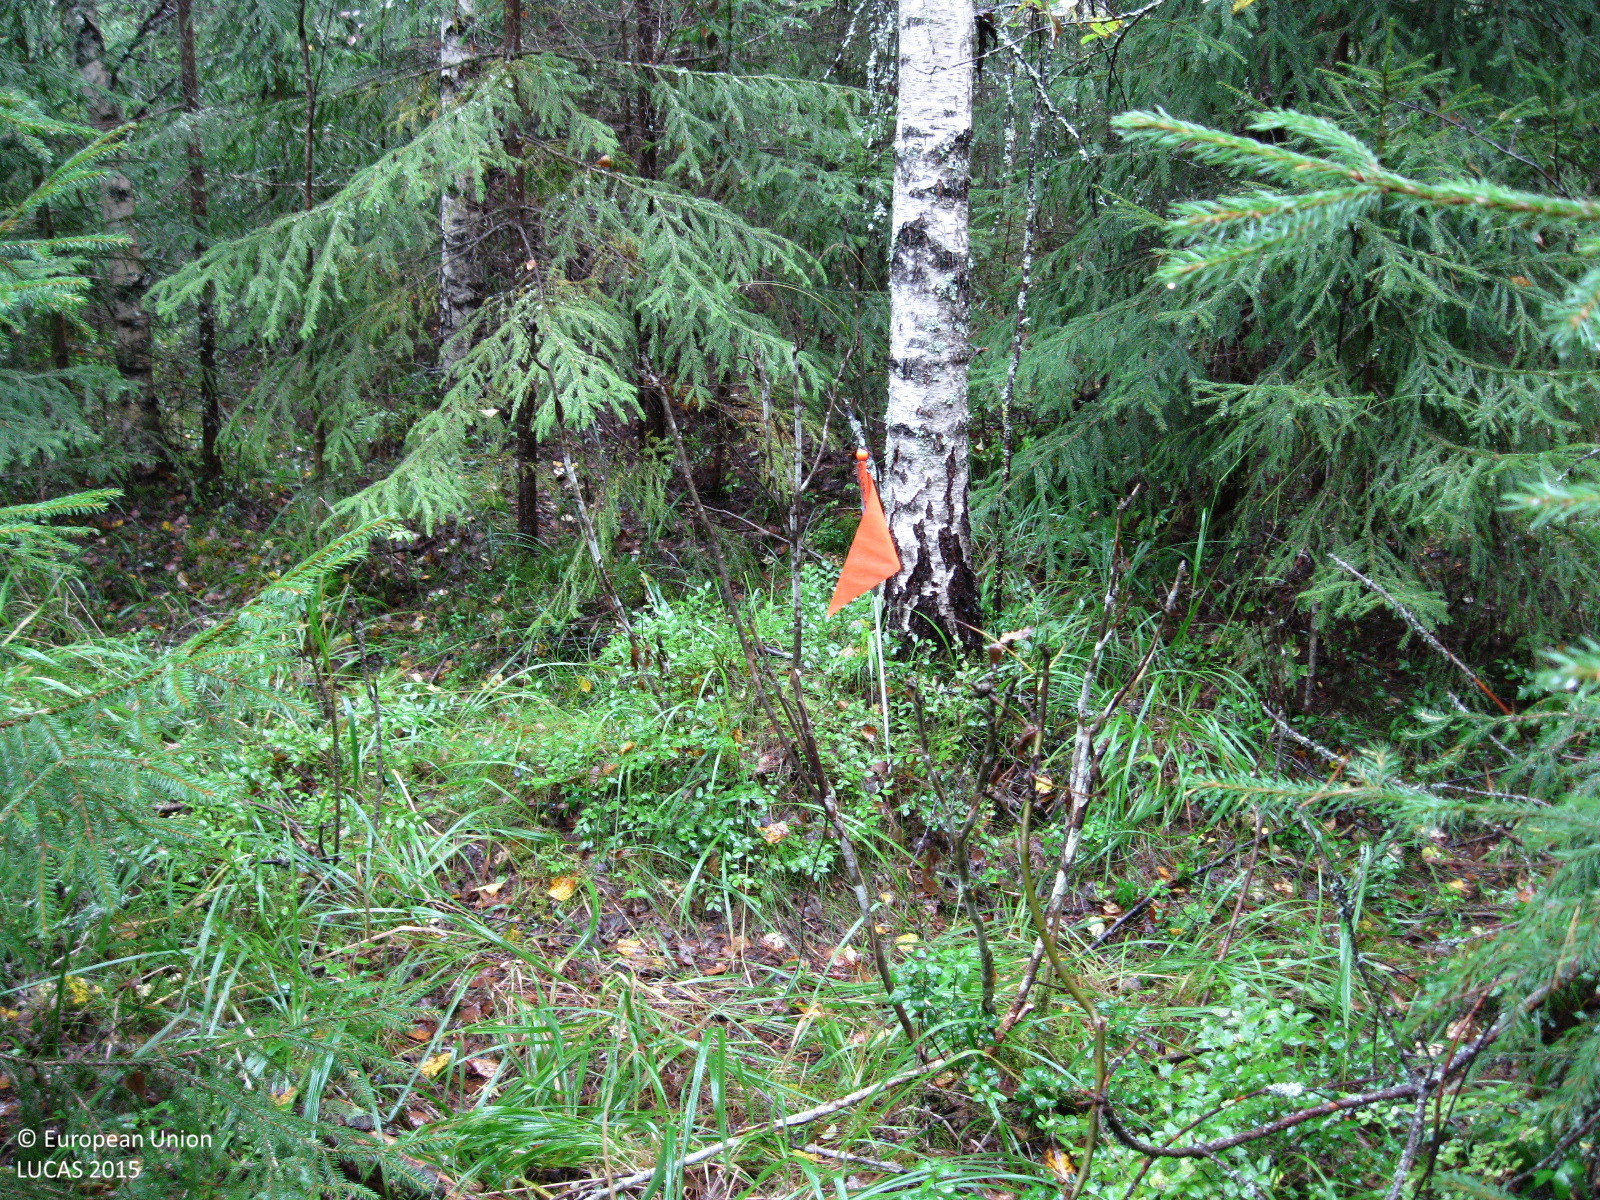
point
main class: Woodland
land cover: Other mixed woodland
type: boreal forest
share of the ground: > 75 %
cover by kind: coniferous forest trees 50 %, broadleaved forest trees 35 %, shrubs 5 %, herbaceous plants 5 %, lichens and mosses 5 %
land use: Semi-natural and natural areas not in use
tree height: > 5 m
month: September
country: FI
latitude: 60.3487
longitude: 24.6252
